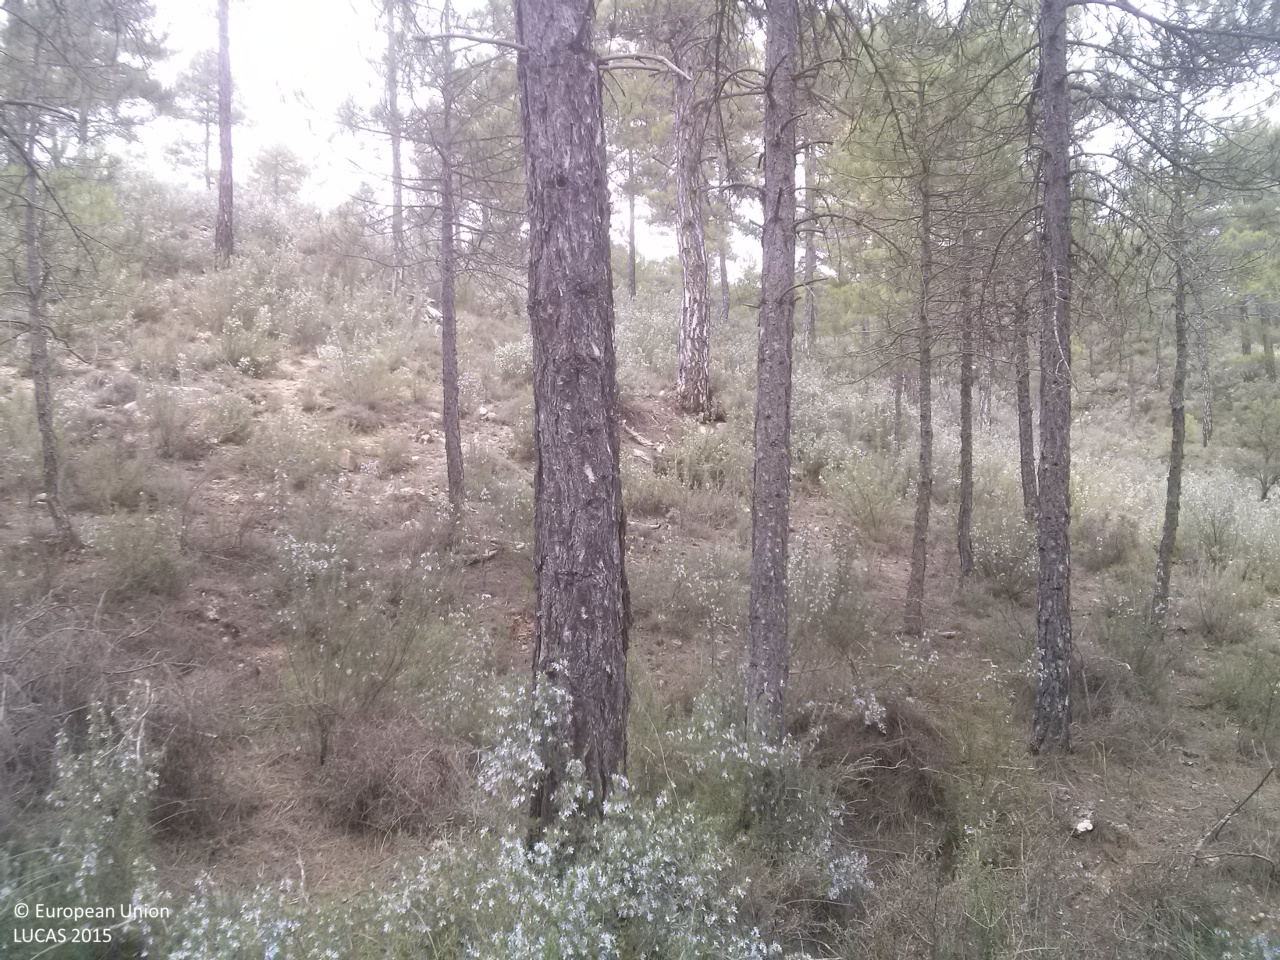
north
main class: Woodland
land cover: Pine dominated coniferous woodland
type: coniferous forest of the mediterranean region
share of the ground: 50 - 75 %
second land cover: Shrubland without tree cover
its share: 50 - 75 %
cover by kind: coniferous forest trees 75 %, herbaceous plants 20 %, shrubs 5 %
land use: Forestry
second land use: Agriculture (excluding fallow land and kitchen gardens)
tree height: > 5 m
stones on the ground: < 10 %
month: April
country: ES
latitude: 39.9969
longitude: -1.9013
